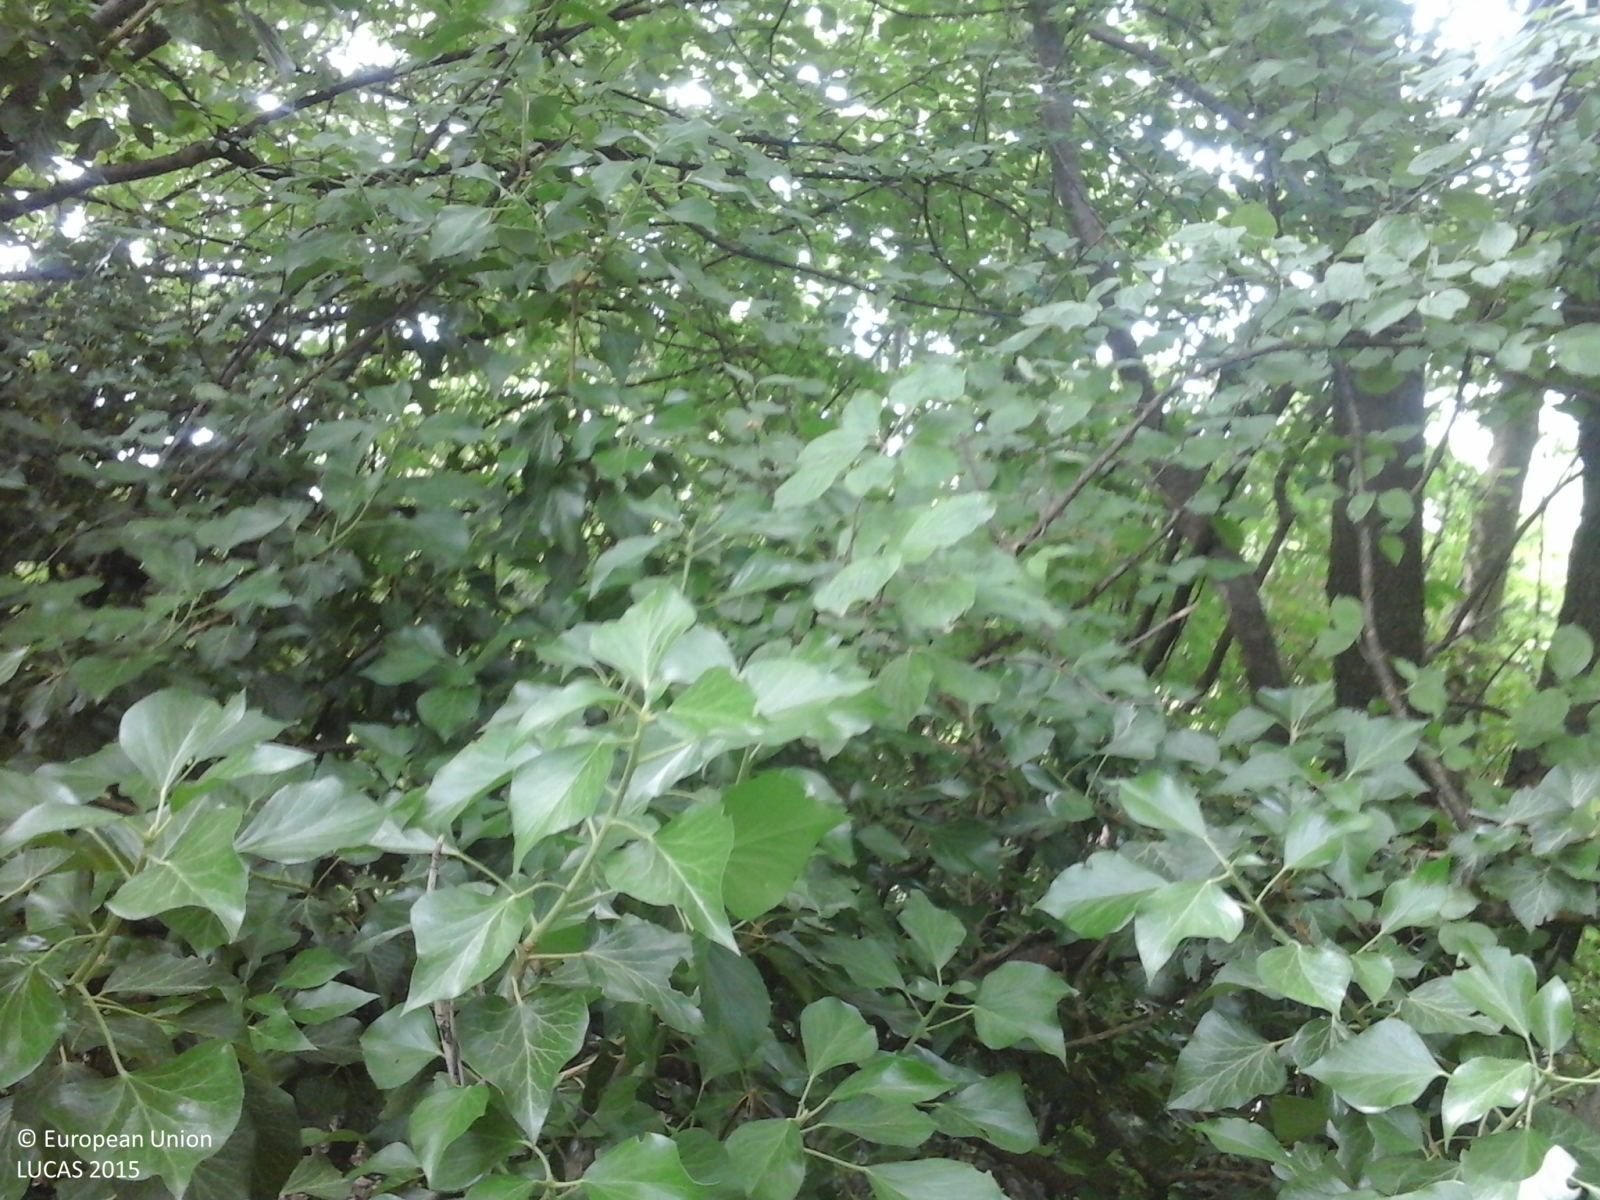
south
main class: Woodland
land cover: Broadleaved woodland
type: thermophilous deciduous forest
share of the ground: > 75 %
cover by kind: broadleaved forest trees 100 %
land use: Forestry
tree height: > 5 m
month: June
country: IT
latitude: 45.7817
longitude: 11.5283
